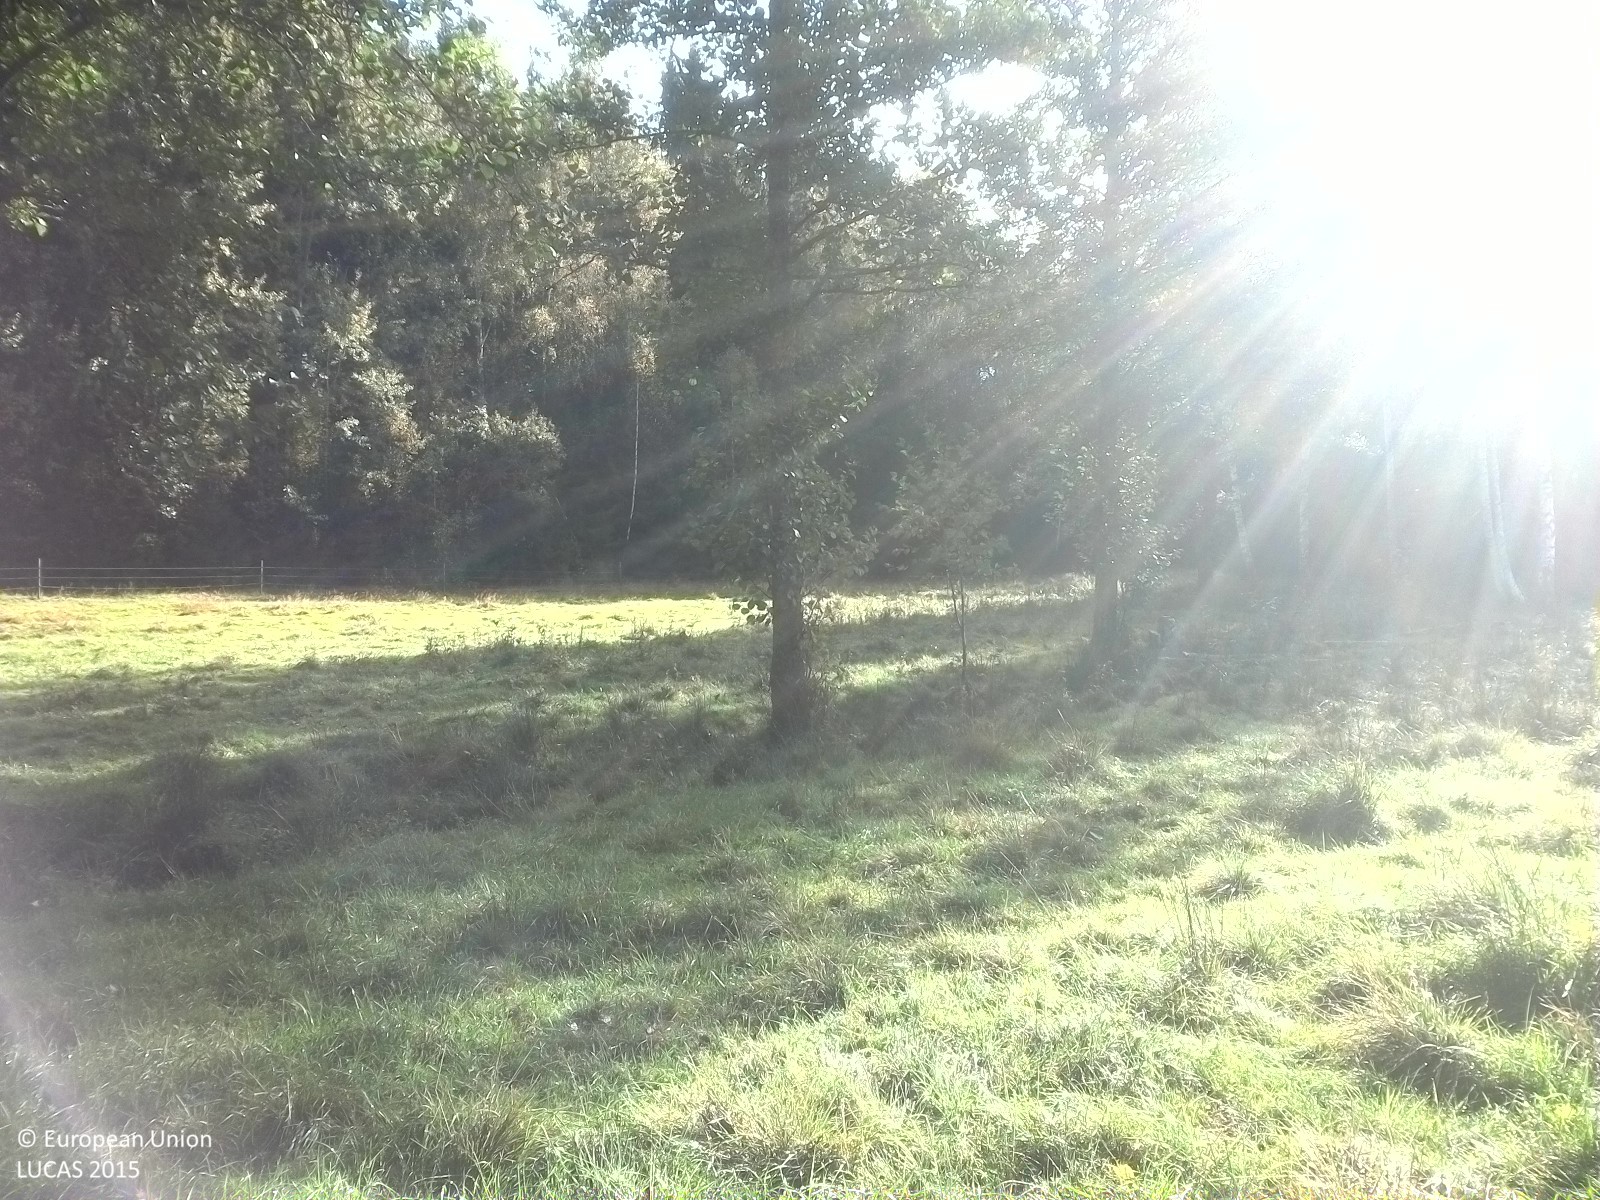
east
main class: Grassland
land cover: Grassland without tree/shrub cover
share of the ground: > 75 %
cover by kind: herbaceous plants 100 %
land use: Agriculture (excluding fallow land and kitchen gardens)
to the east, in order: Grassland without tree/shrub cover; Ditches and canals; Single bushes/trees; Grassland without tree/shrub cover; Fences; Grassland without tree/shrub cover; Spruce dominated coniferous woodland; Ditches and canals; Spruce dominated coniferous woodland
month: September
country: SE
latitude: 58.9582
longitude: 15.8524
